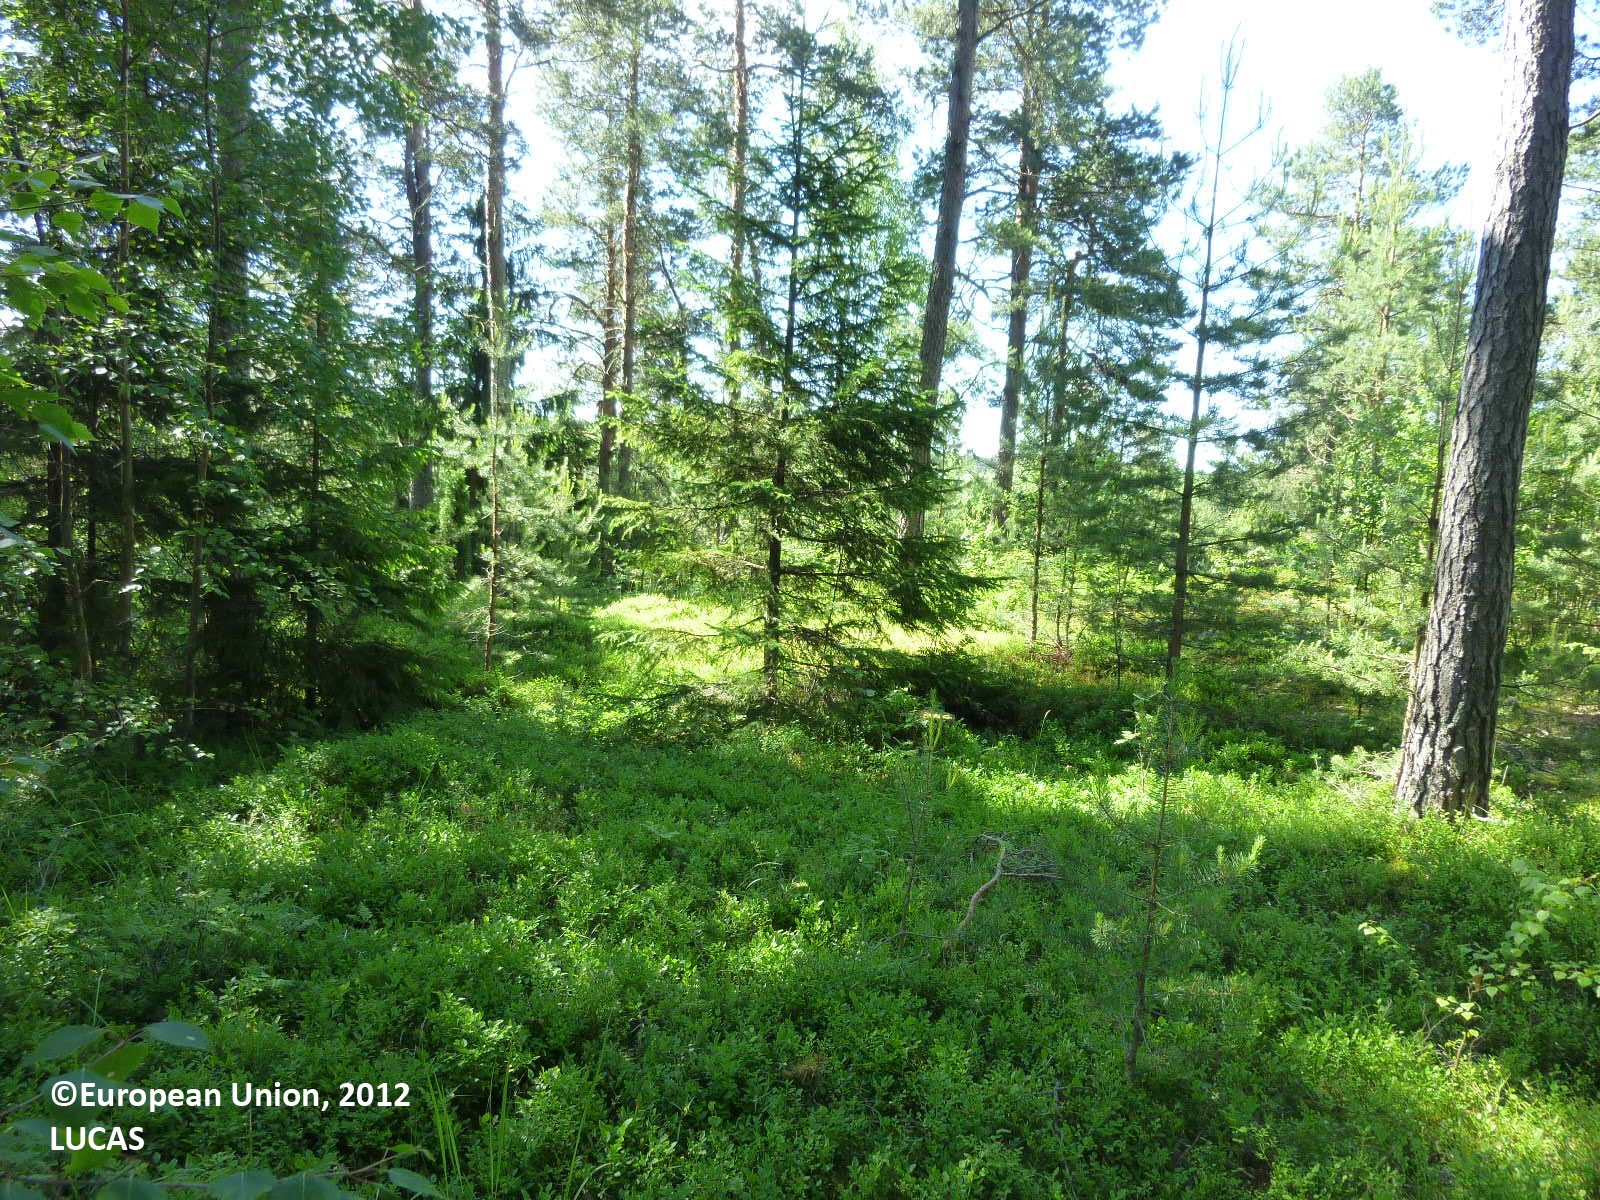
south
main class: Woodland
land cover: Other coniferous woodland
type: boreal forest
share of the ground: 25 - 50 %
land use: Forestry
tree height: > 5 m
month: June
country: FI
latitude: 60.2091
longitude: 22.4679
